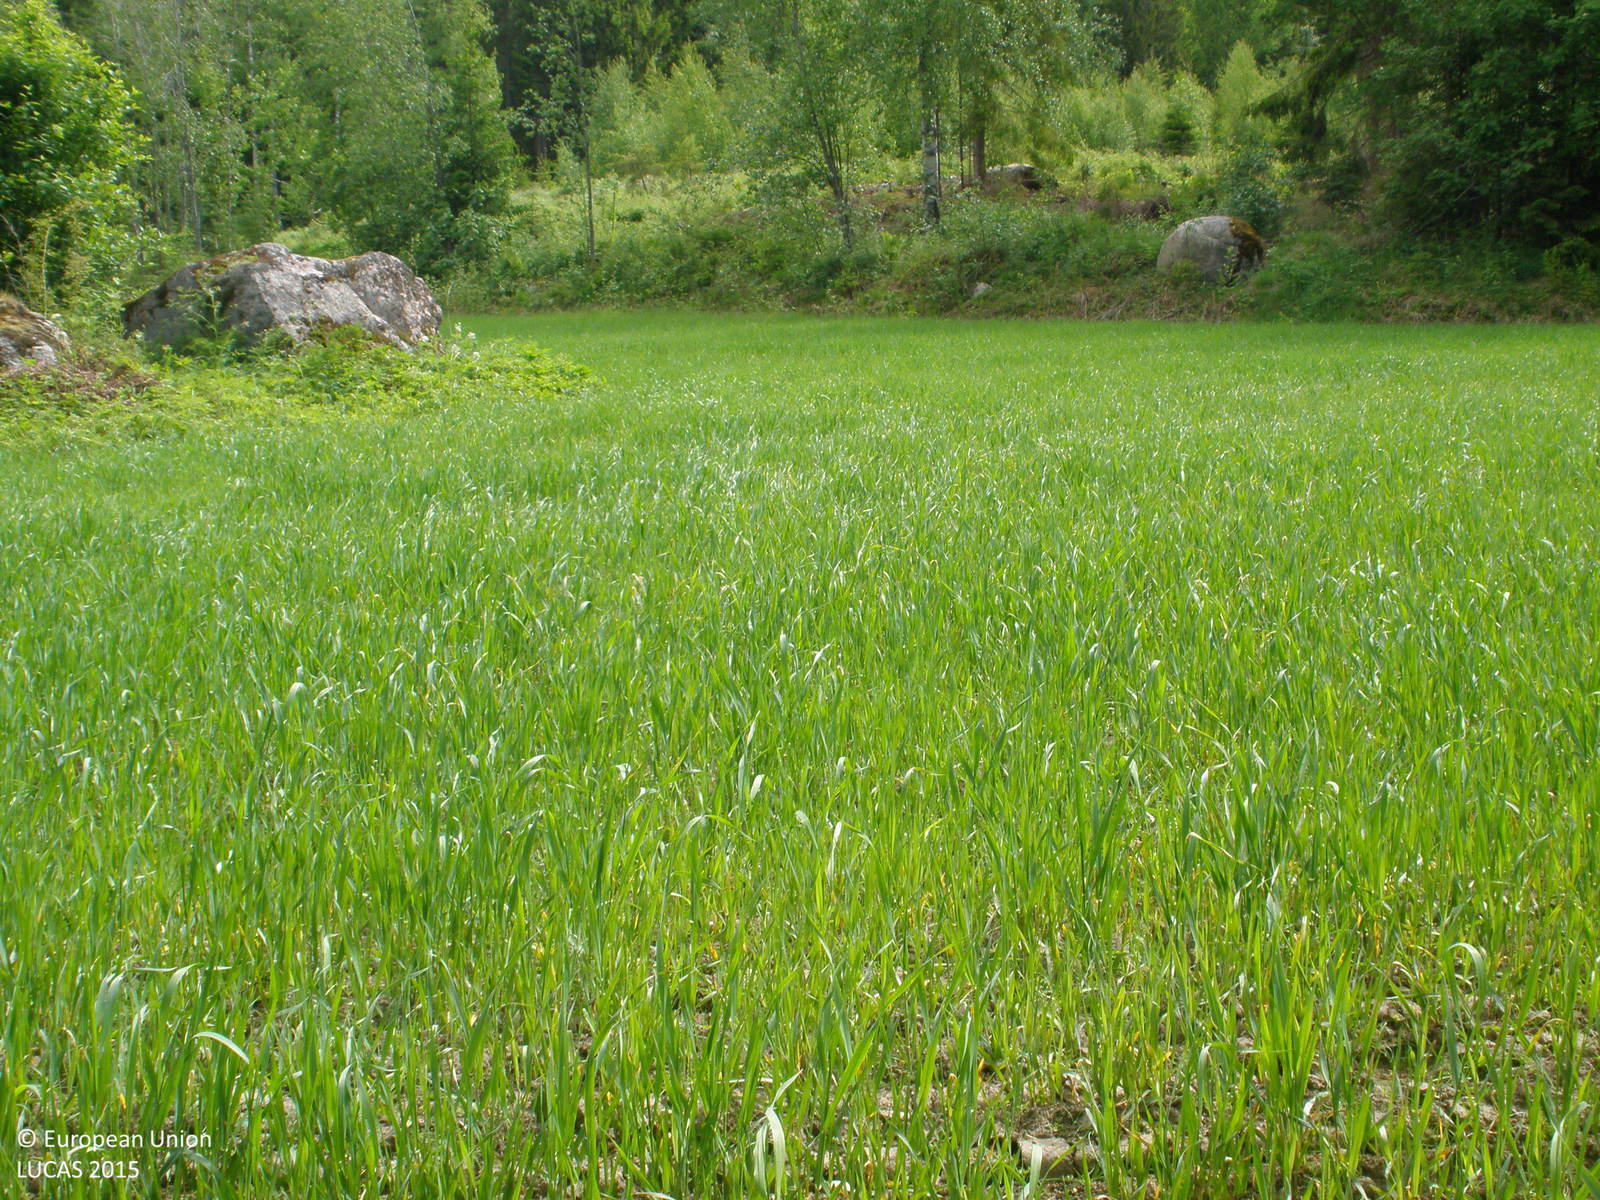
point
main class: Cropland
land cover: Barley
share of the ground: 25 - 50 %
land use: Agriculture (excluding fallow land and kitchen gardens)
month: June
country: FI
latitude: 60.9728
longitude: 24.2683
